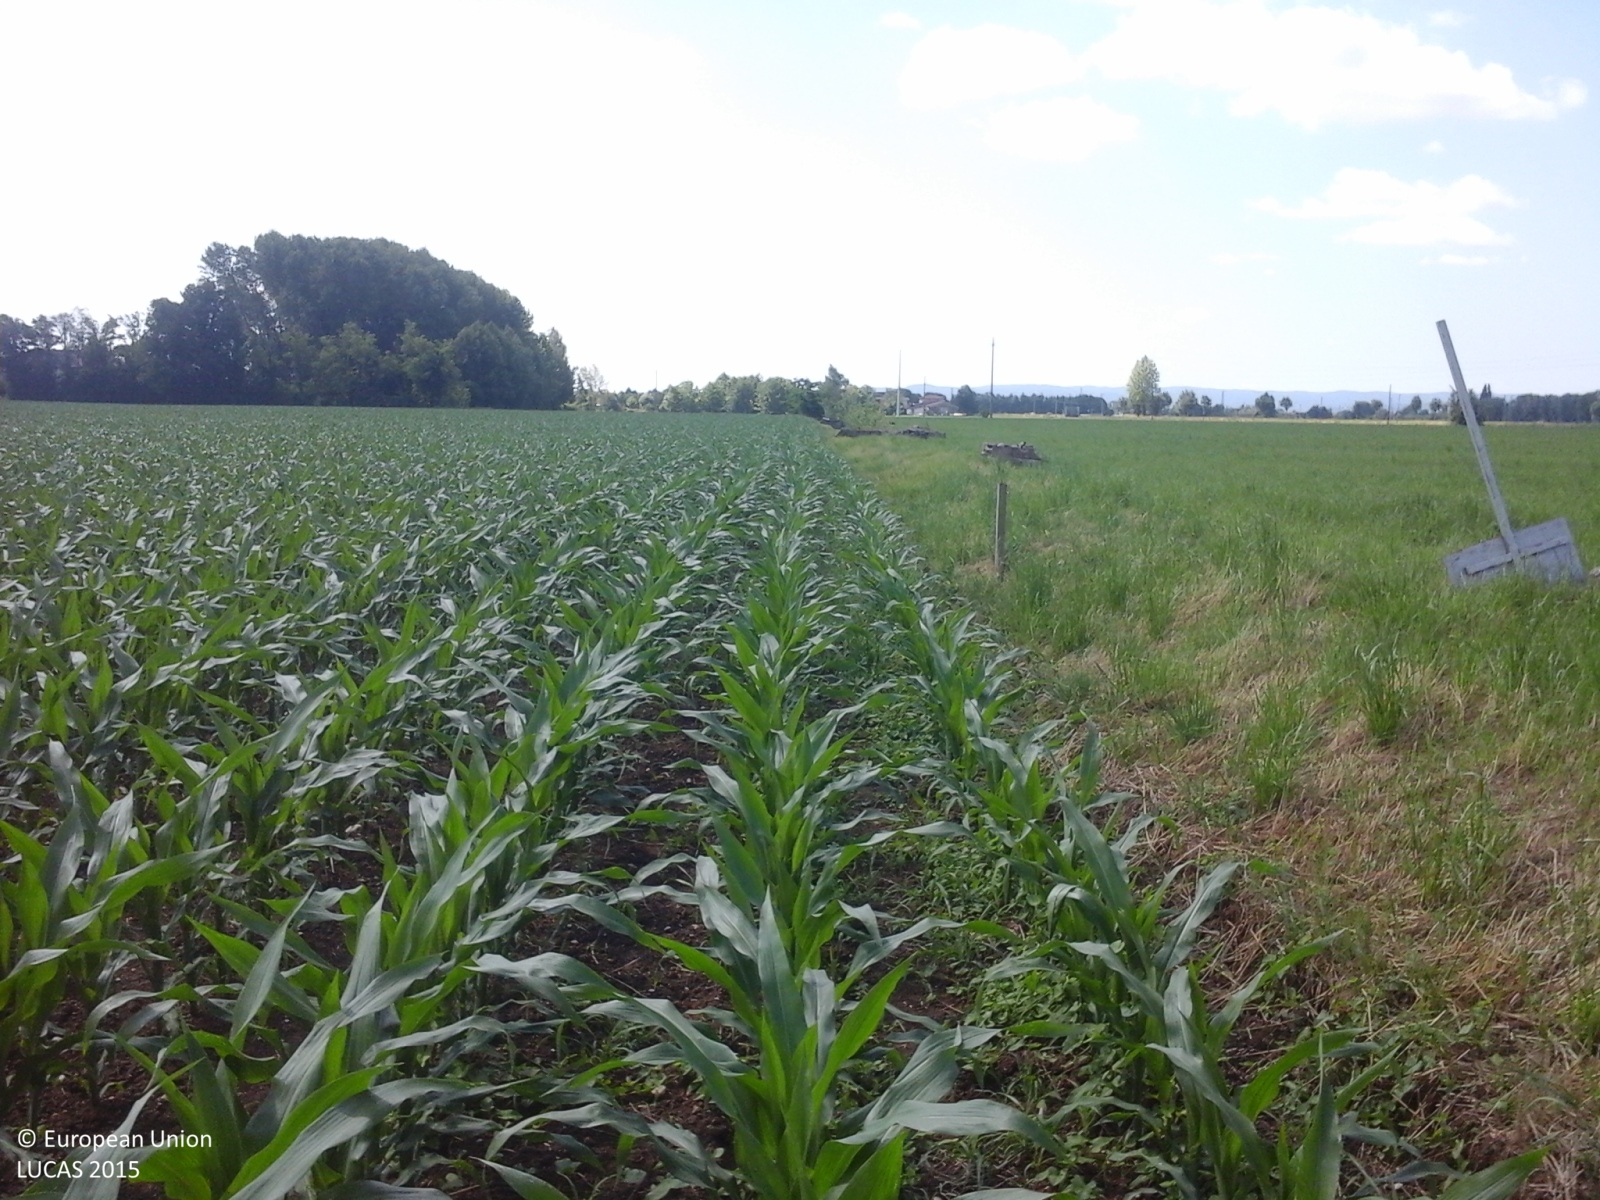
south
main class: Cropland
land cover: Maize
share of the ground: 50 - 75 %
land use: Agriculture (excluding fallow land and kitchen gardens)
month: May
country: IT
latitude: 45.6181
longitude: 11.6261
